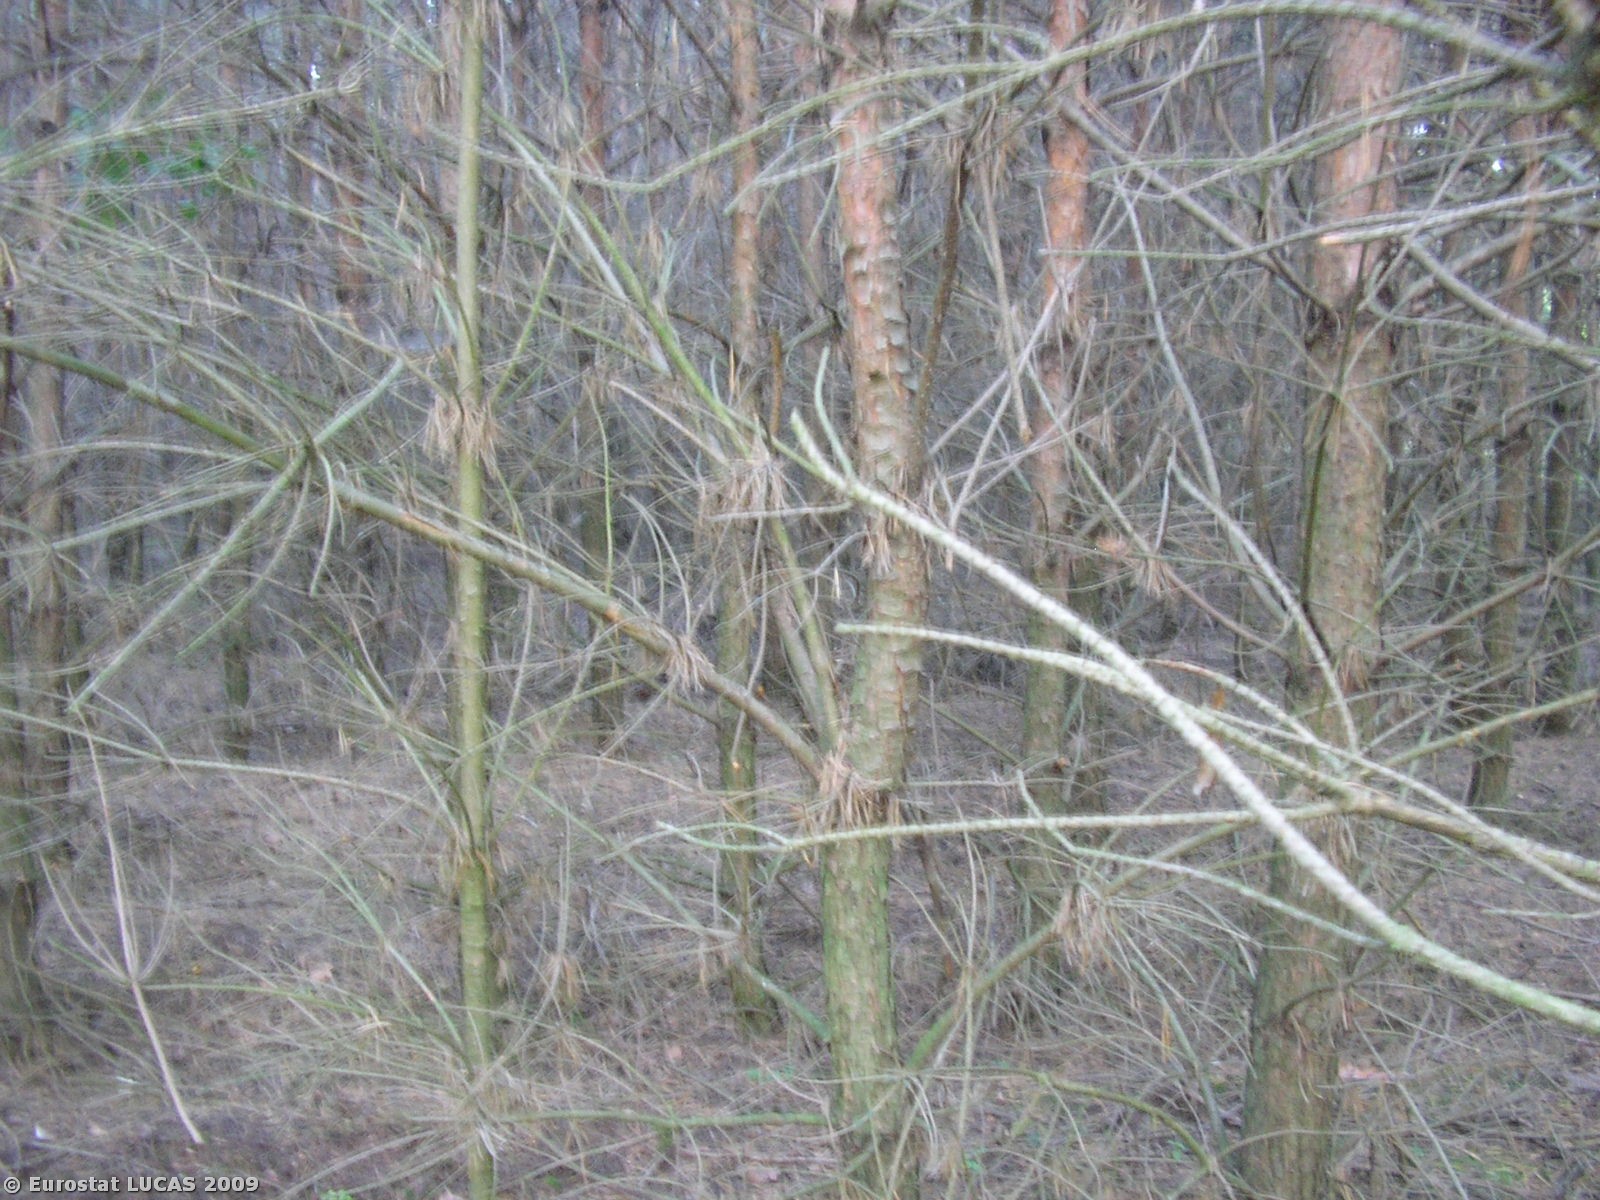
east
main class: Woodland
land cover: Coniferous woodland
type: hemiboreal forest and nemoral coniferous forest and mixed broadleaved-coniferous forest
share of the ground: > 75 %
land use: Forestry
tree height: > 5 m
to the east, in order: Coniferous woodland; Grass margins; Rye; Grass margins; Tracks; Grass margins; Fences; Abandoned hedges; Fences; Grassland without tree/shrub cover
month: September
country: PL
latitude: 51.7083
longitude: 21.1168
